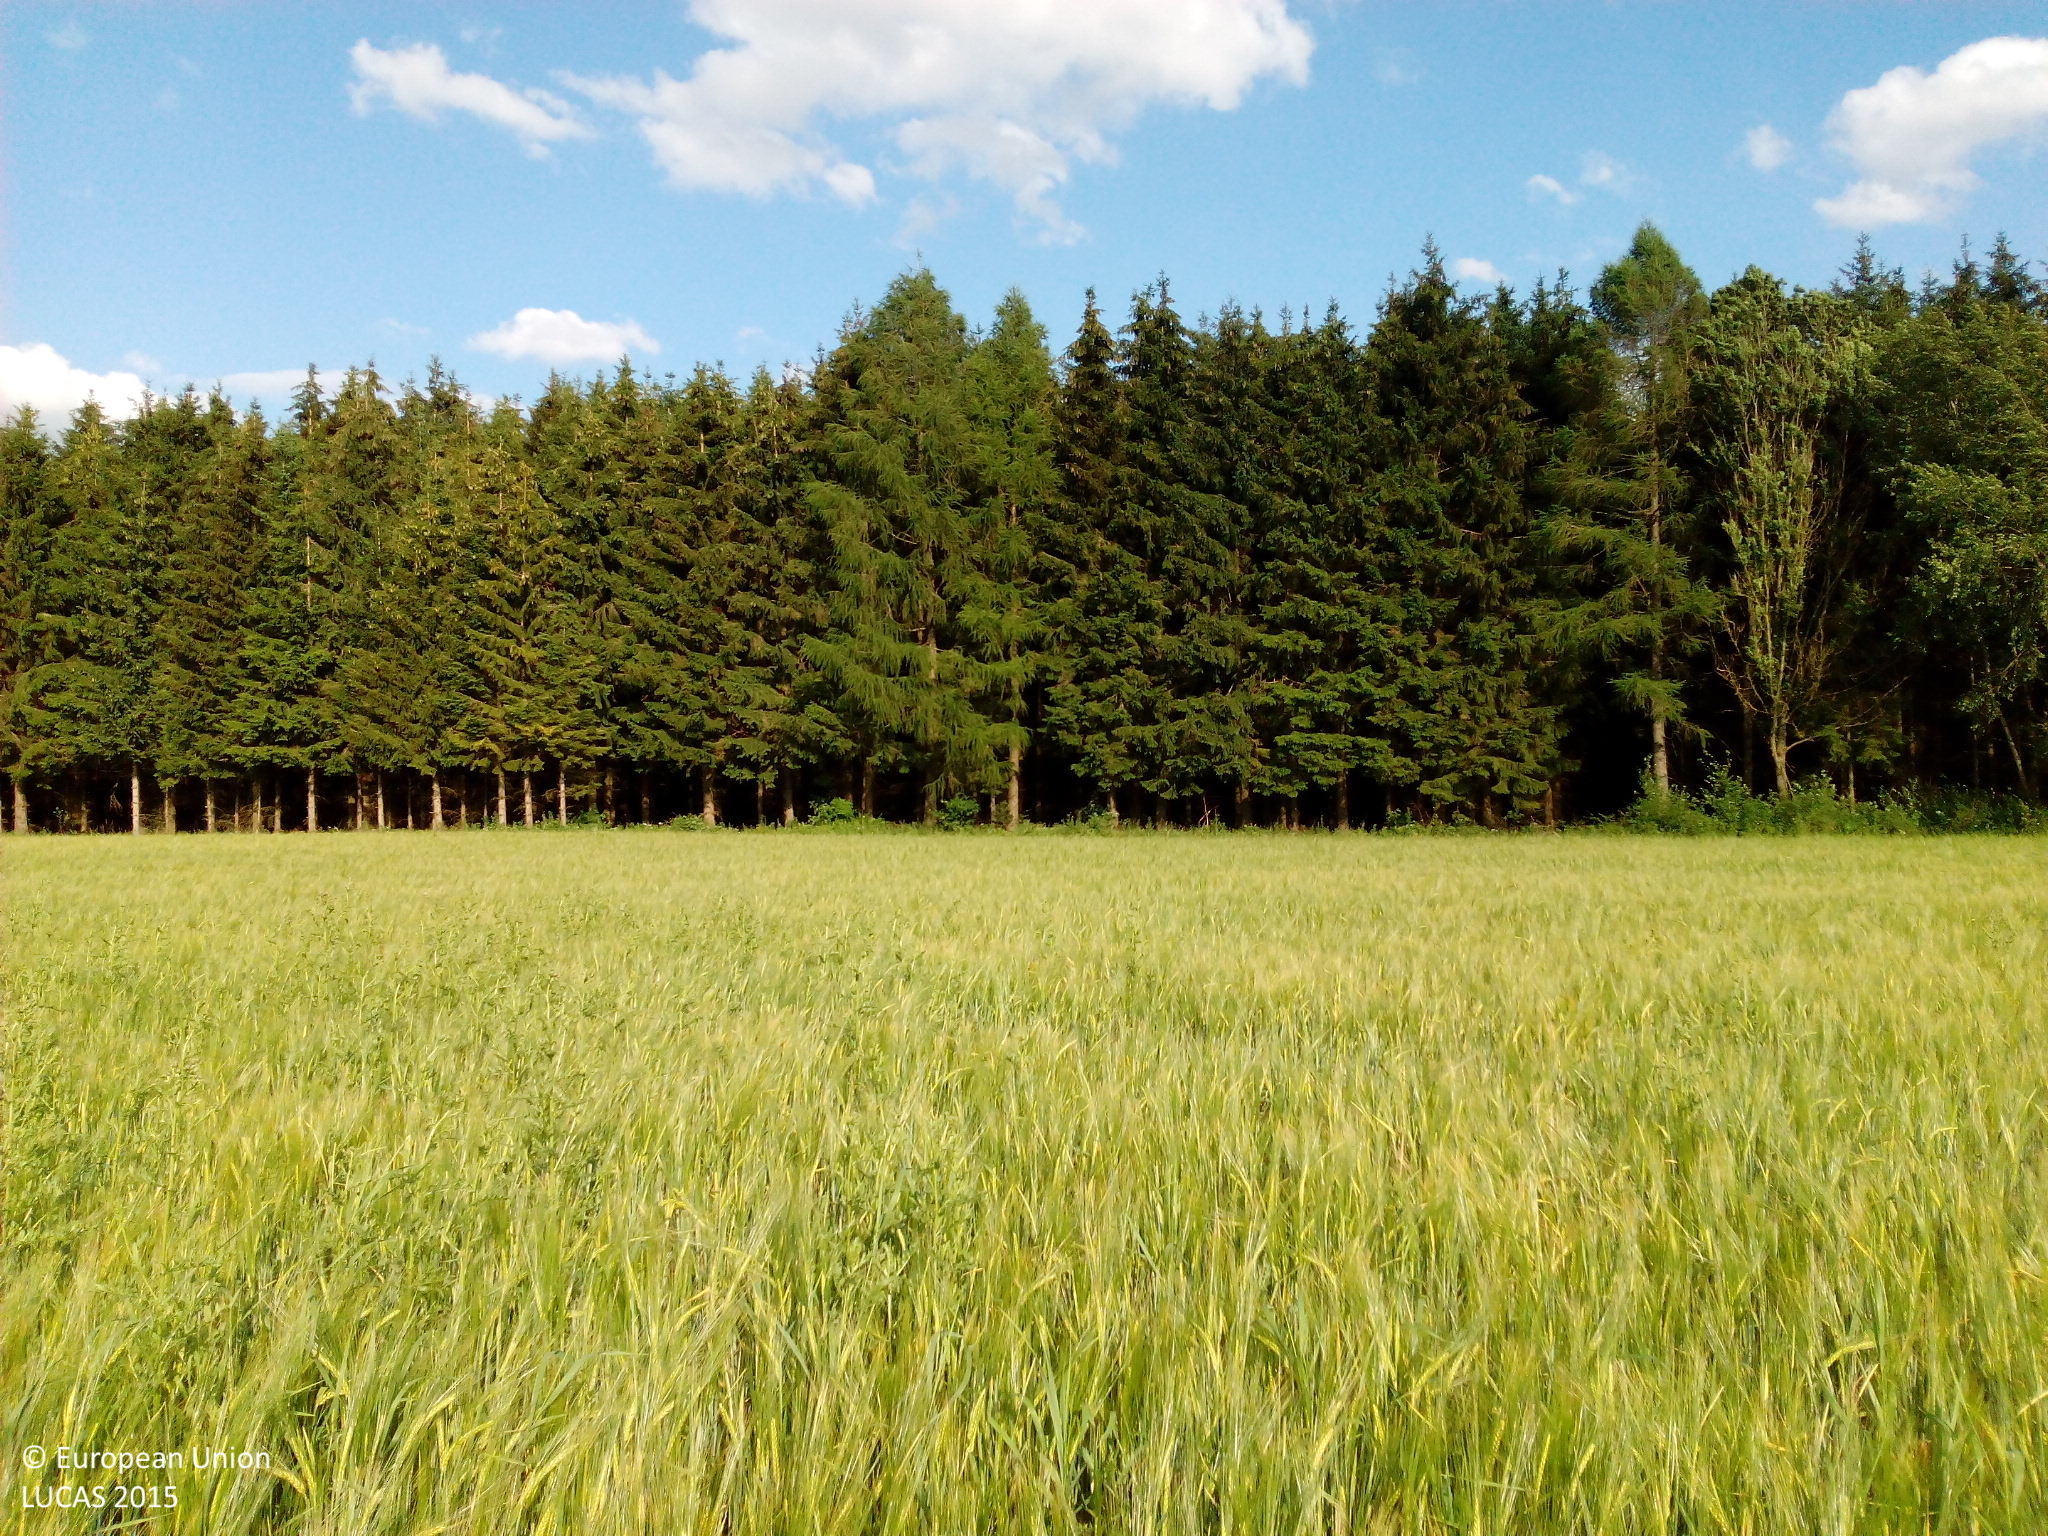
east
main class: Cropland
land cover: Barley
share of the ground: > 75 %
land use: Agriculture (excluding fallow land and kitchen gardens)
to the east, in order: Barley; Grassland without tree/shrub cover; Spruce dominated coniferous woodland; Tracks; Spruce dominated coniferous woodland; Broadleaved woodland
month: July
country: DE
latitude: 48.6373
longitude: 9.8508
